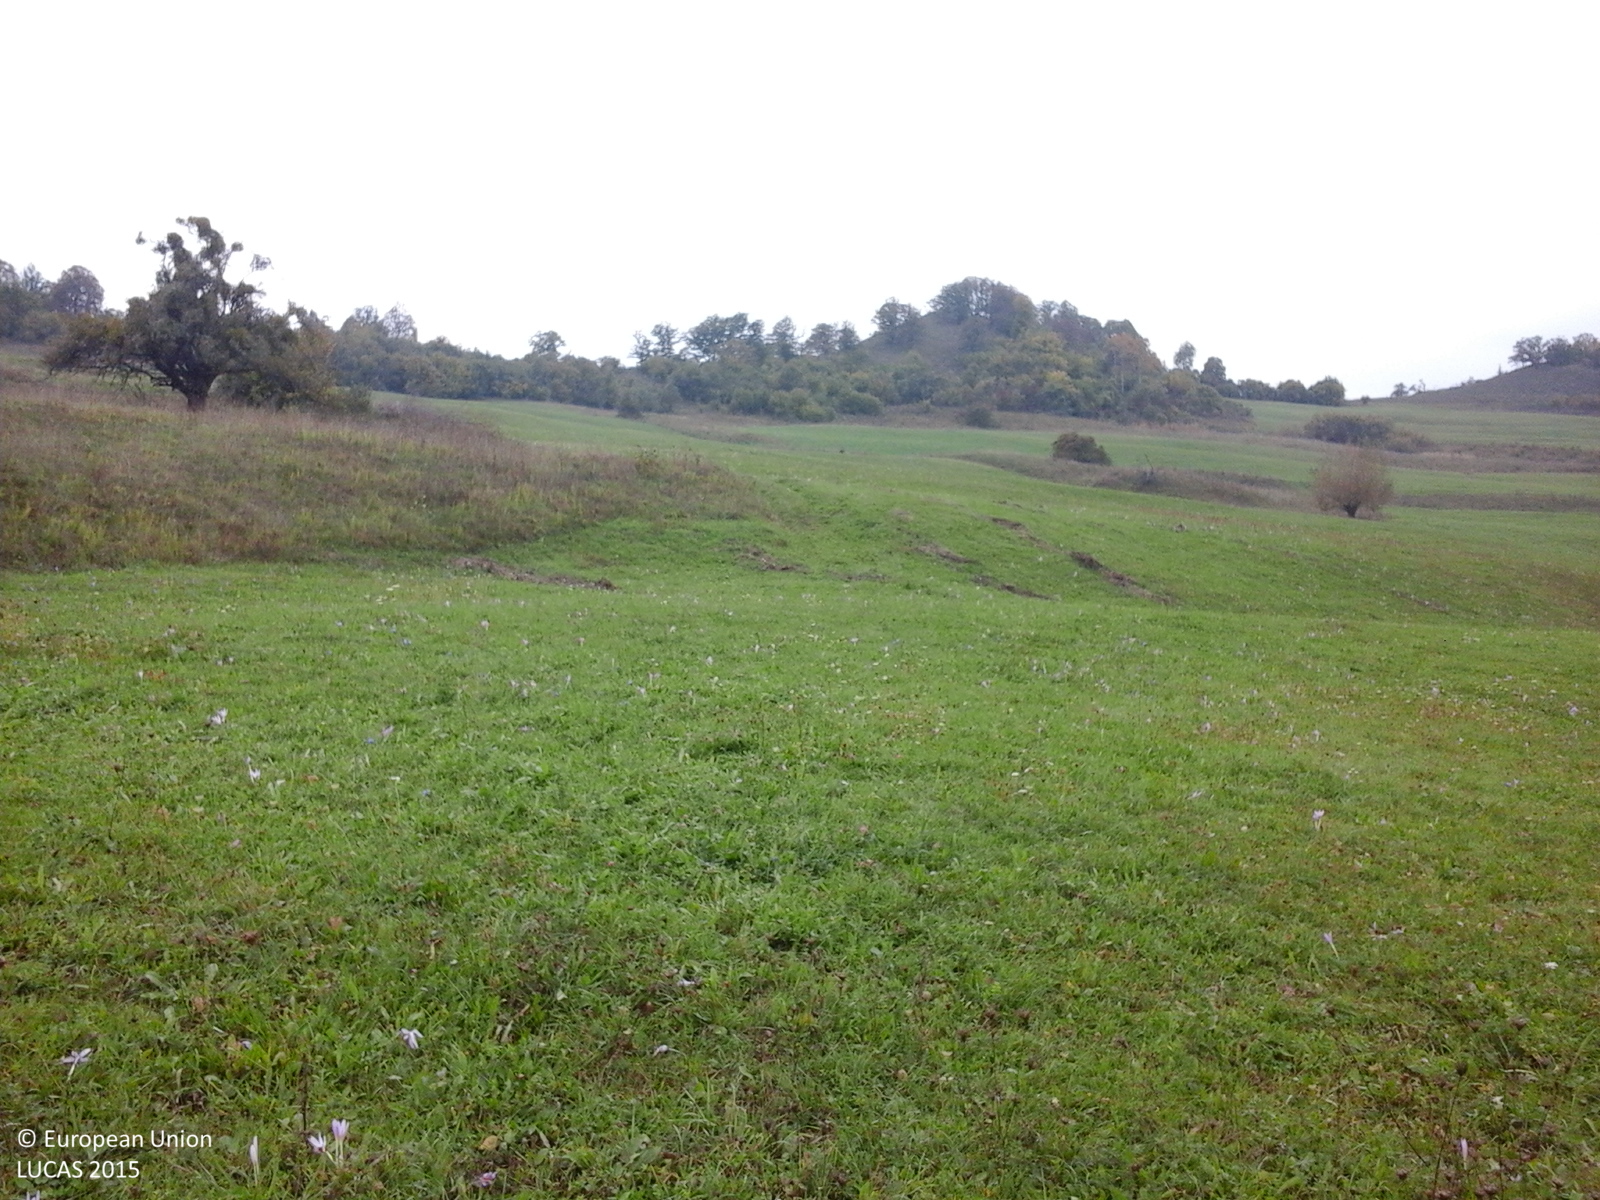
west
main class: Grassland
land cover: Grassland without tree/shrub cover
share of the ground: > 75 %
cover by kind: herbaceous plants 100 %
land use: Agriculture (excluding fallow land and kitchen gardens)
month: October
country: RO
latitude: 46.2601
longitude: 24.8429
